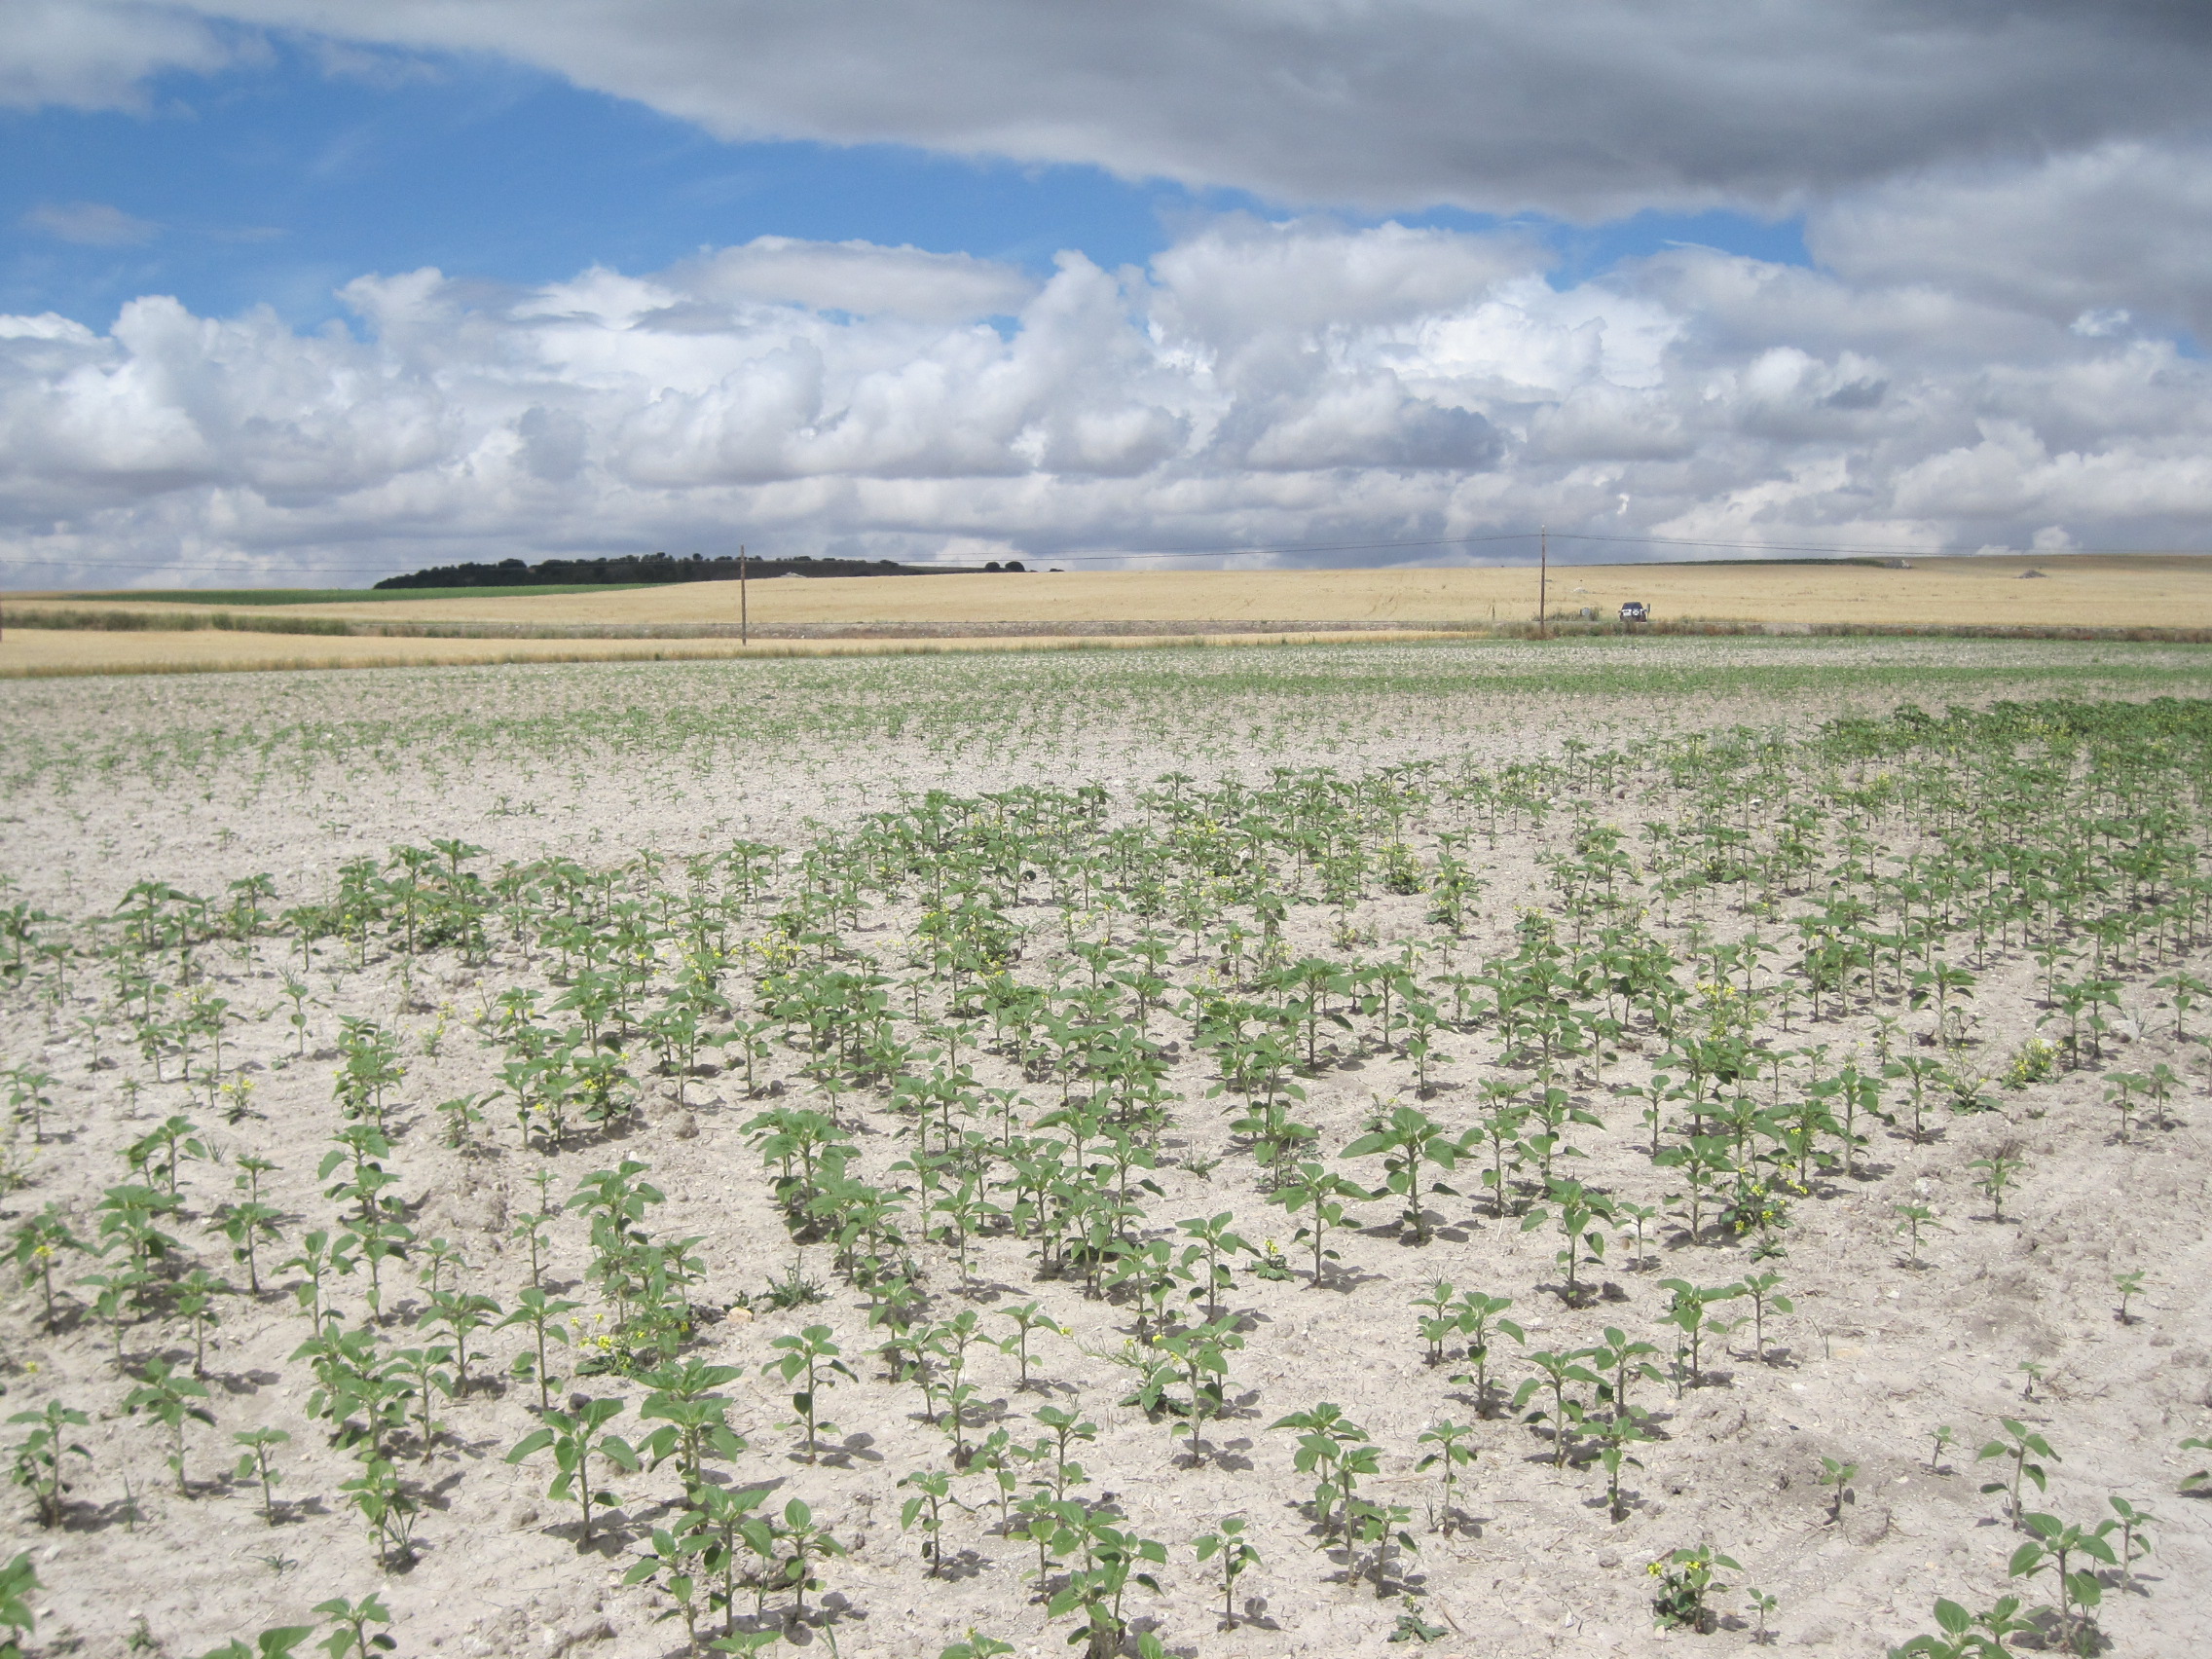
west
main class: Cropland
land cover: Sunflower
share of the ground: 25 - 50 %
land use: Agriculture (excluding fallow land and kitchen gardens)
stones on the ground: < 10 %
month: June
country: ES
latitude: 41.7959
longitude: -4.6921
